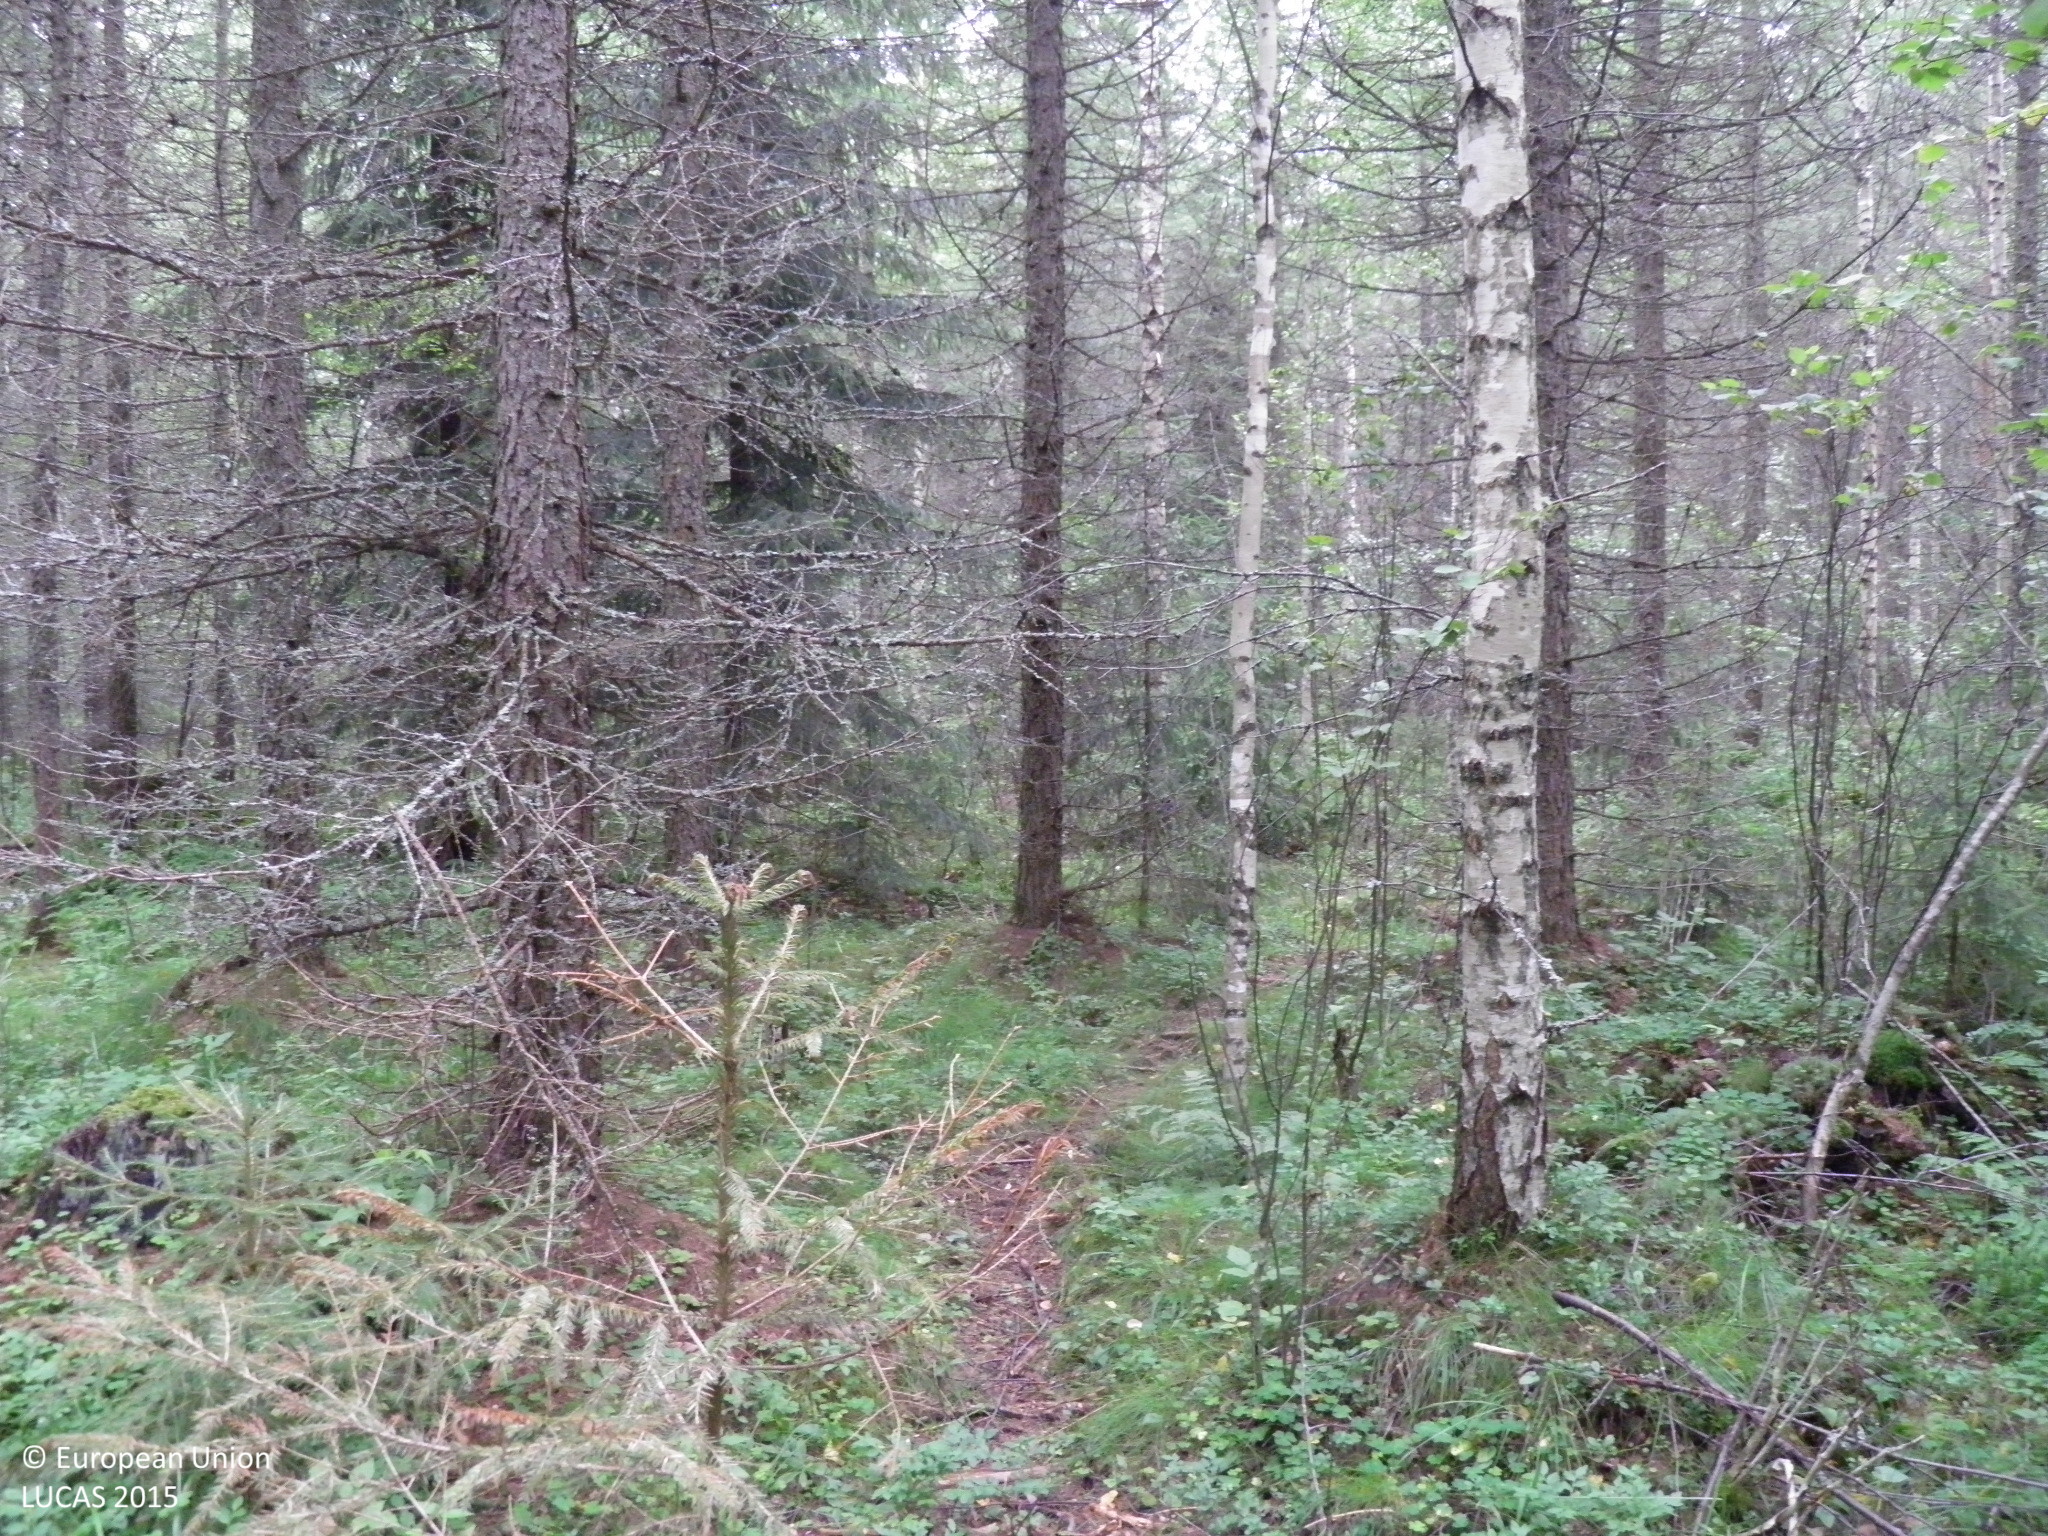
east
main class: Woodland
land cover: Pine dominated mixed woodland
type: hemiboreal forest and nemoral coniferous forest and mixed broadleaved-coniferous forest
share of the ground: > 75 %
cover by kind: broadleaved forest trees 45 %, coniferous forest trees 40 %, shrubs 5 %, herbaceous plants 5 %, lichens and mosses 5 %
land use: Forestry
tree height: > 5 m
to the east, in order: Pine dominated mixed woodland; Ditches and canals; Pine dominated mixed woodland; Ditches and canals; Pine dominated coniferous woodland; Ditches and canals; Spruce dominated coniferous woodland
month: July
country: FI
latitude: 60.8642
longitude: 22.9075
